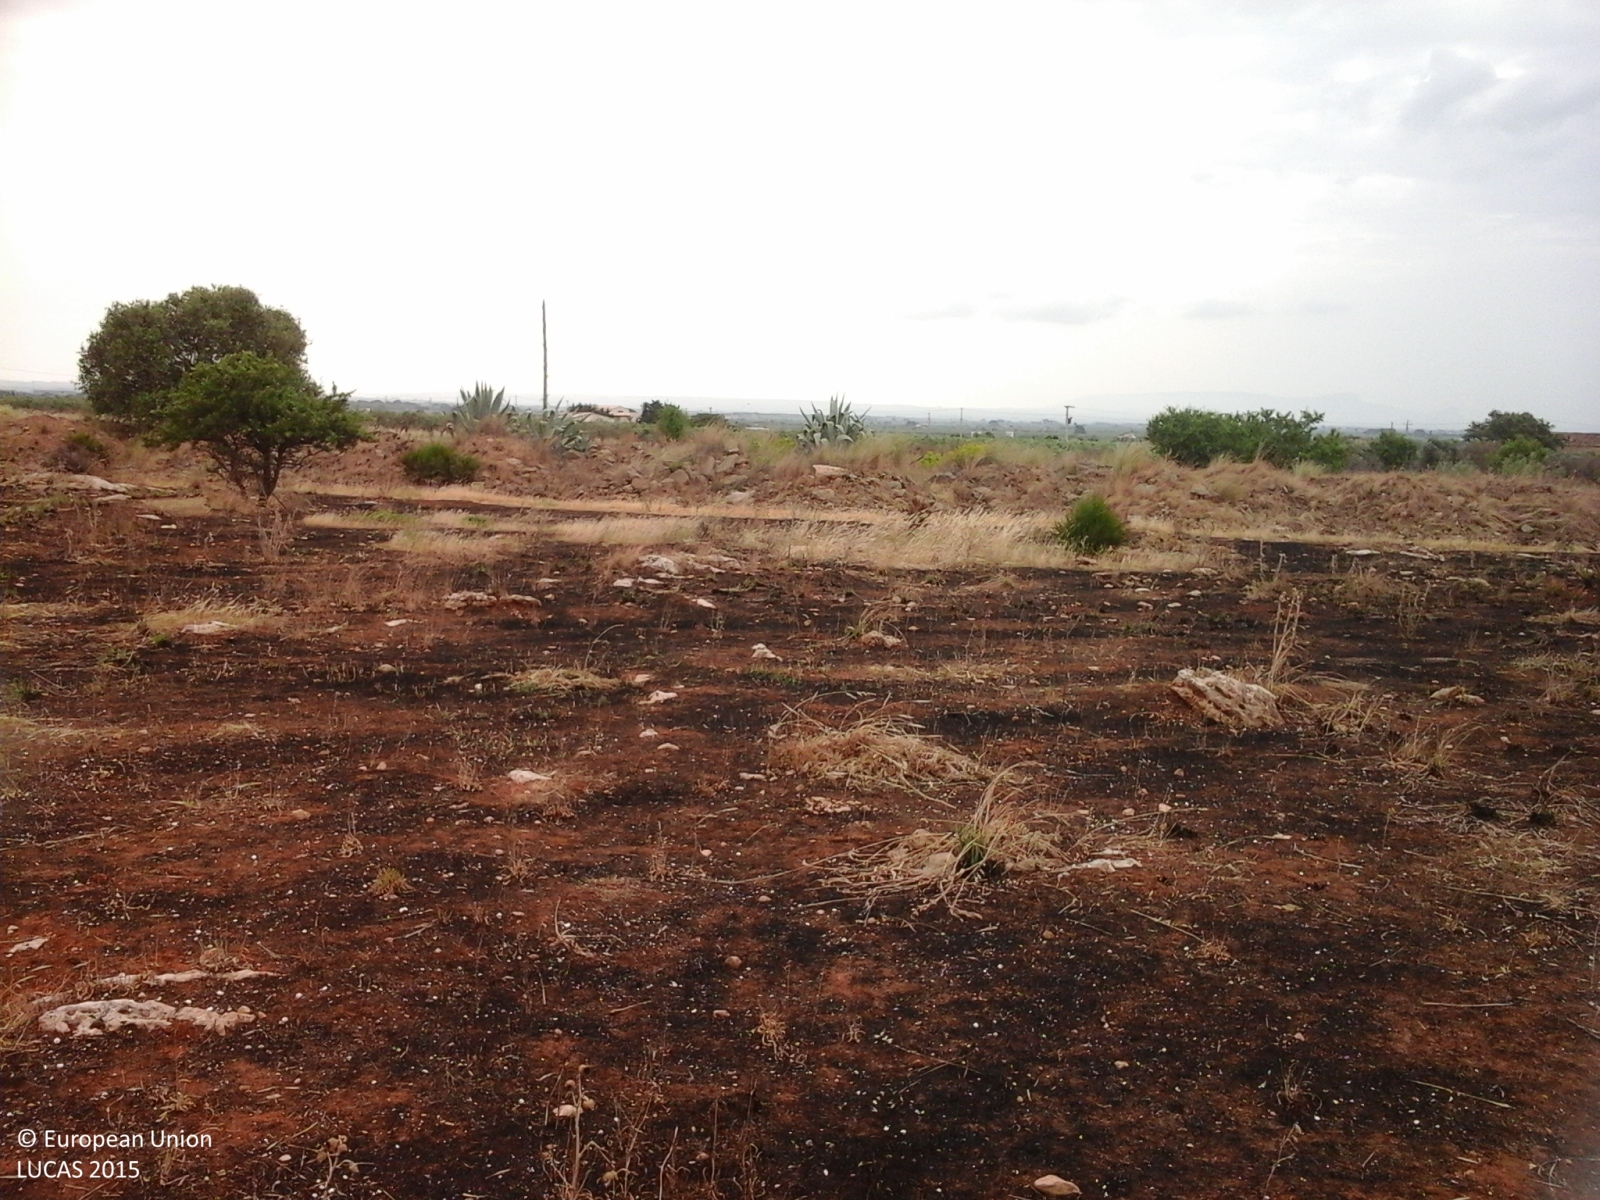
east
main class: Grassland
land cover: Grassland with sparse tree/shrub cover
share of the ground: > 75 %
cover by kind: consolidated bare surface 65 %, herbaceous plants 20 %, shrubs 10 %, coniferous forest trees 5 %
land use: Semi-natural and natural areas not in use
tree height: < 5 m
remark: Burnt area
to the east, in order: Grassland with sparse tree/shrub cover; Tracks; Rocks and stones; Dry stone walls; Grassland without tree/shrub cover; Olive groves
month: May
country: IT
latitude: 37.6168
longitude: 12.7546
